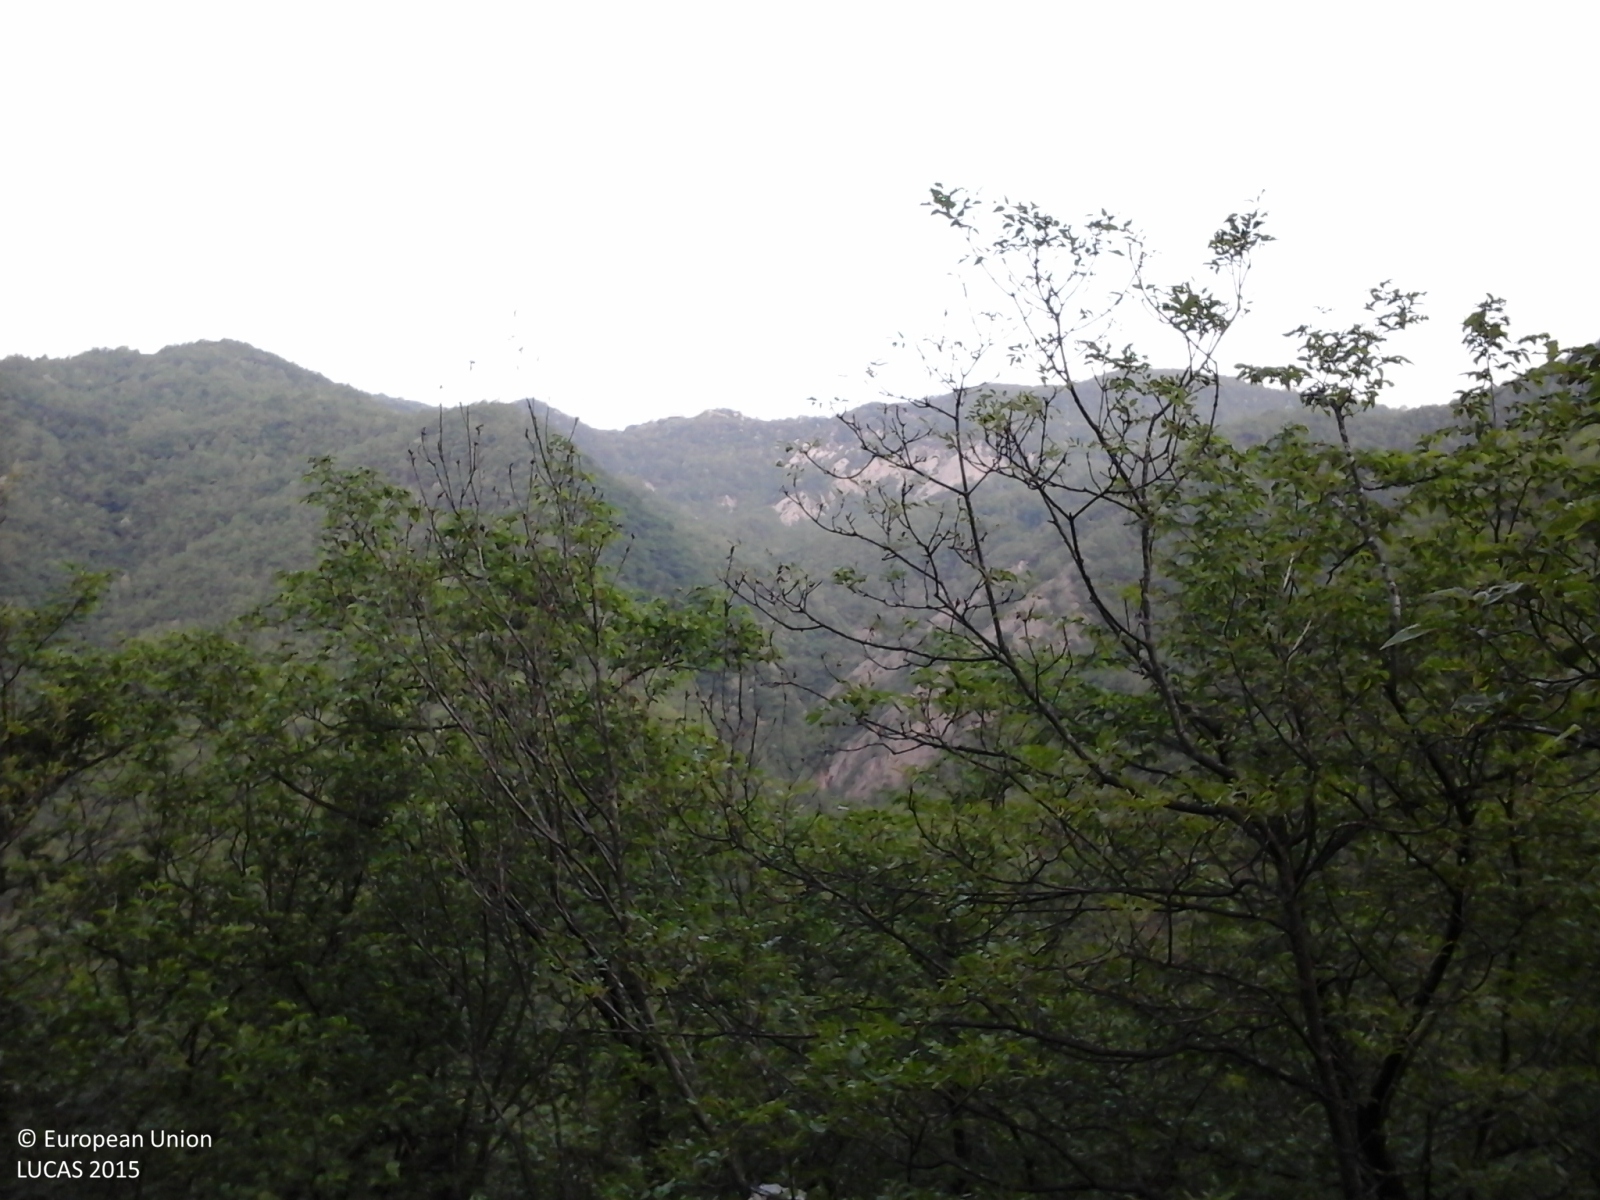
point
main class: Woodland
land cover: Broadleaved woodland
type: mesophytic deciduous forest
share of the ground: > 75 %
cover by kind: broadleaved forest trees 100 %
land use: Forestry
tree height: > 5 m
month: May
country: IT
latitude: 44.7274
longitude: 9.3826
